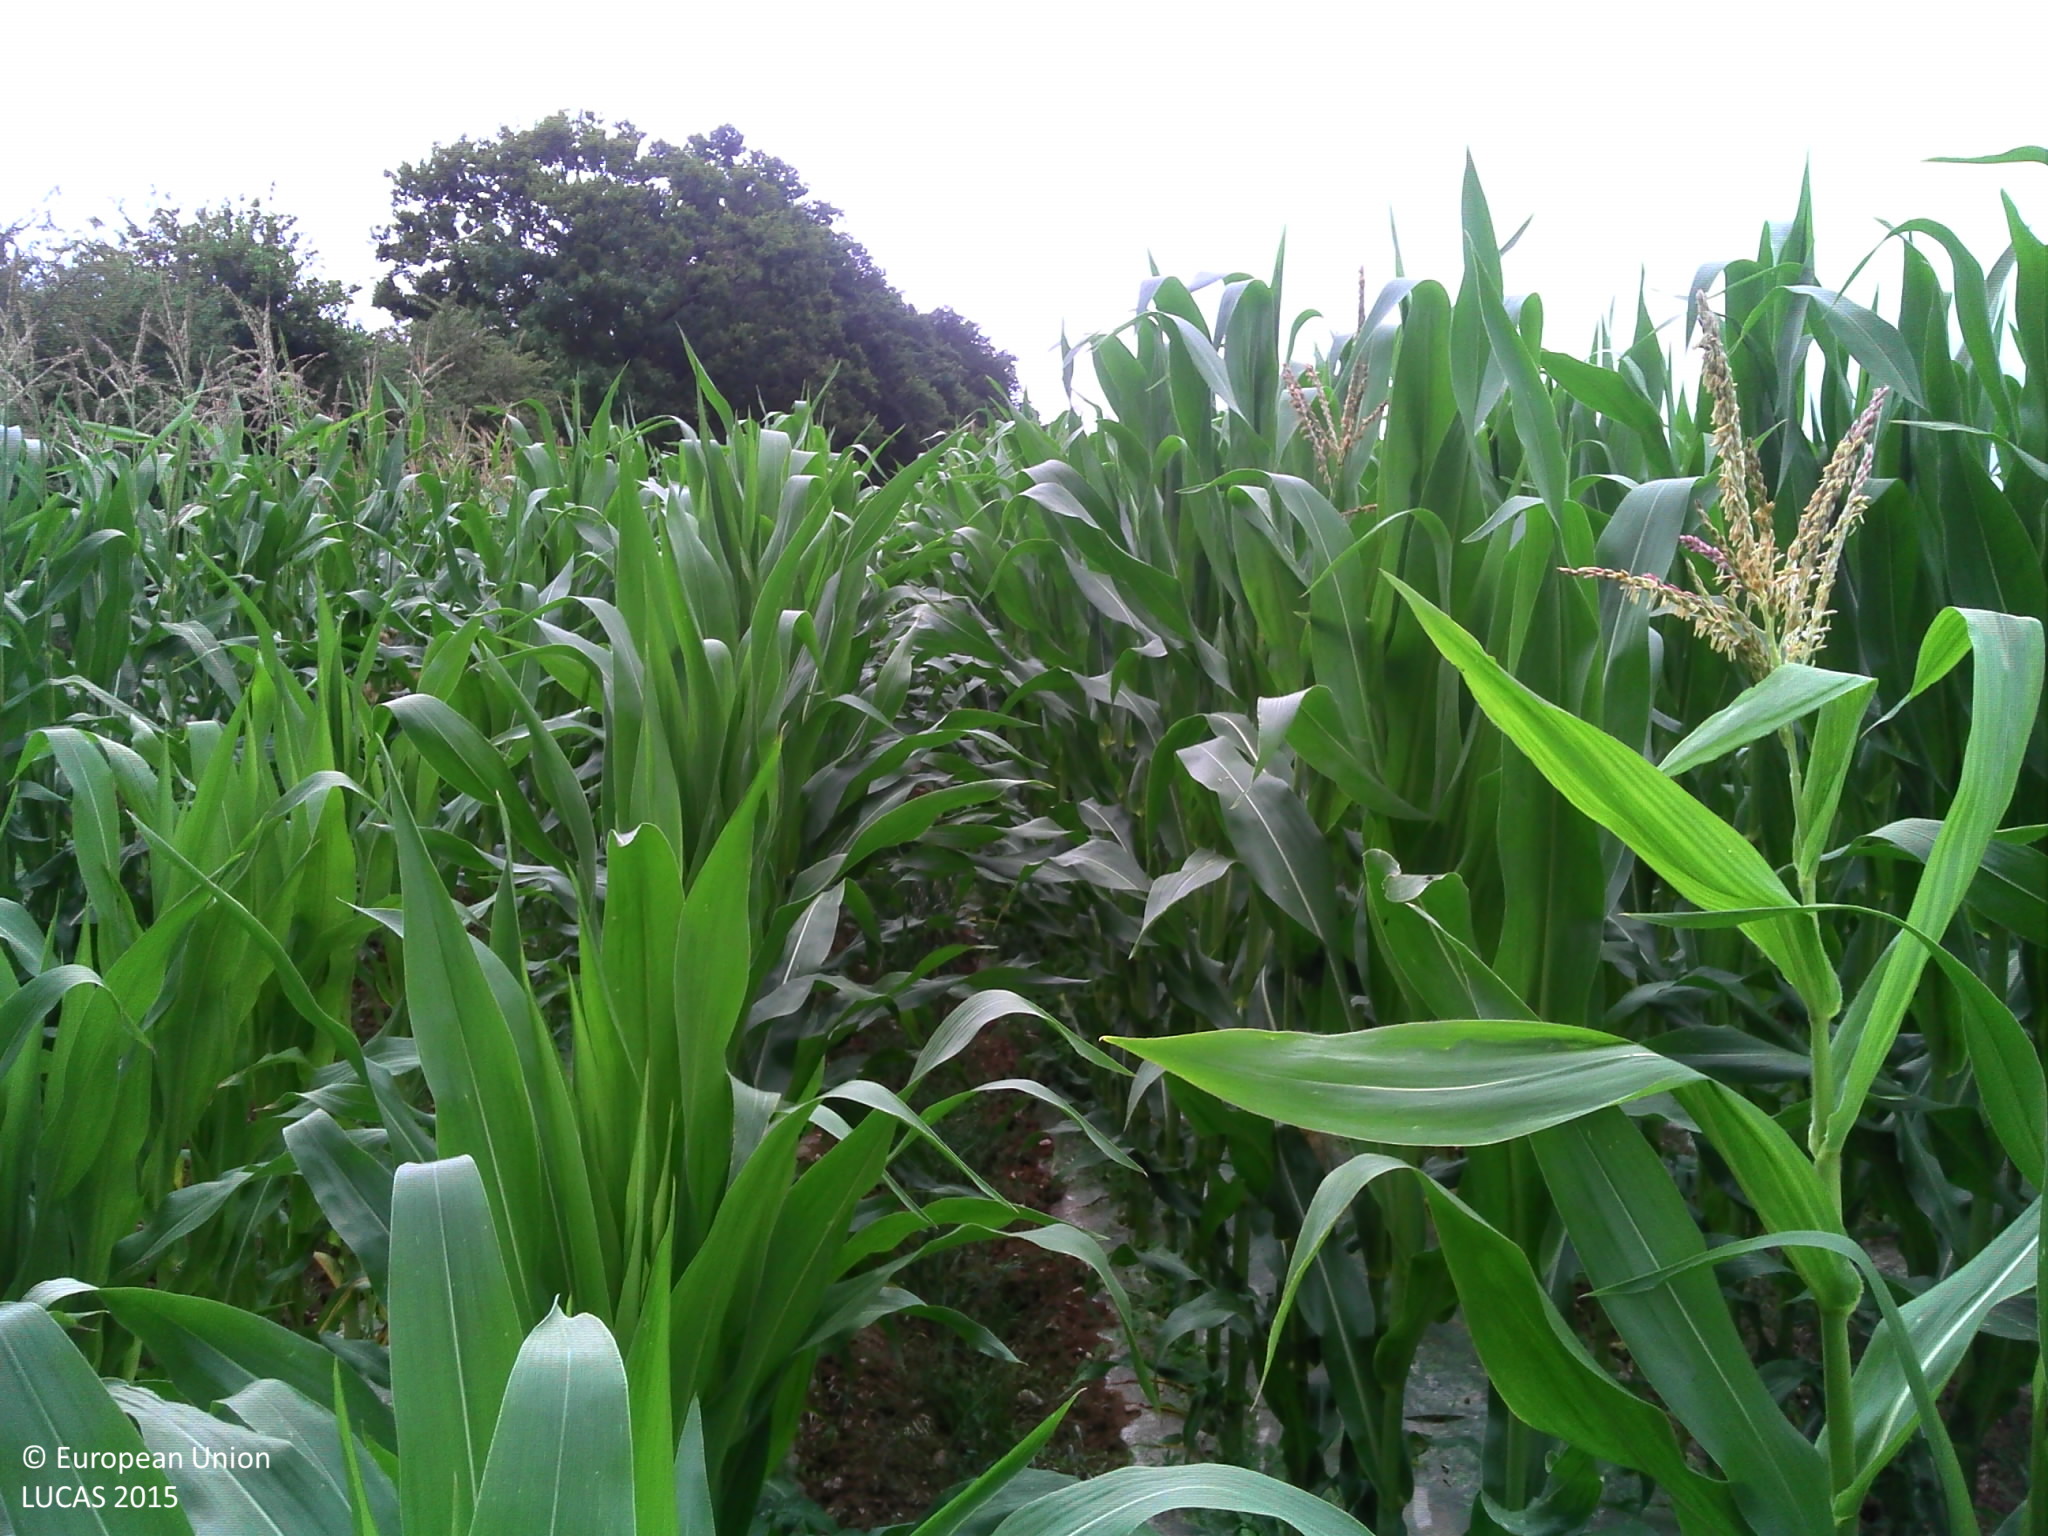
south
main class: Cropland
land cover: Maize
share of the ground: > 75 %
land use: Agriculture (excluding fallow land and kitchen gardens)
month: July
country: FR
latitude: 47.8845
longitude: -2.0748
